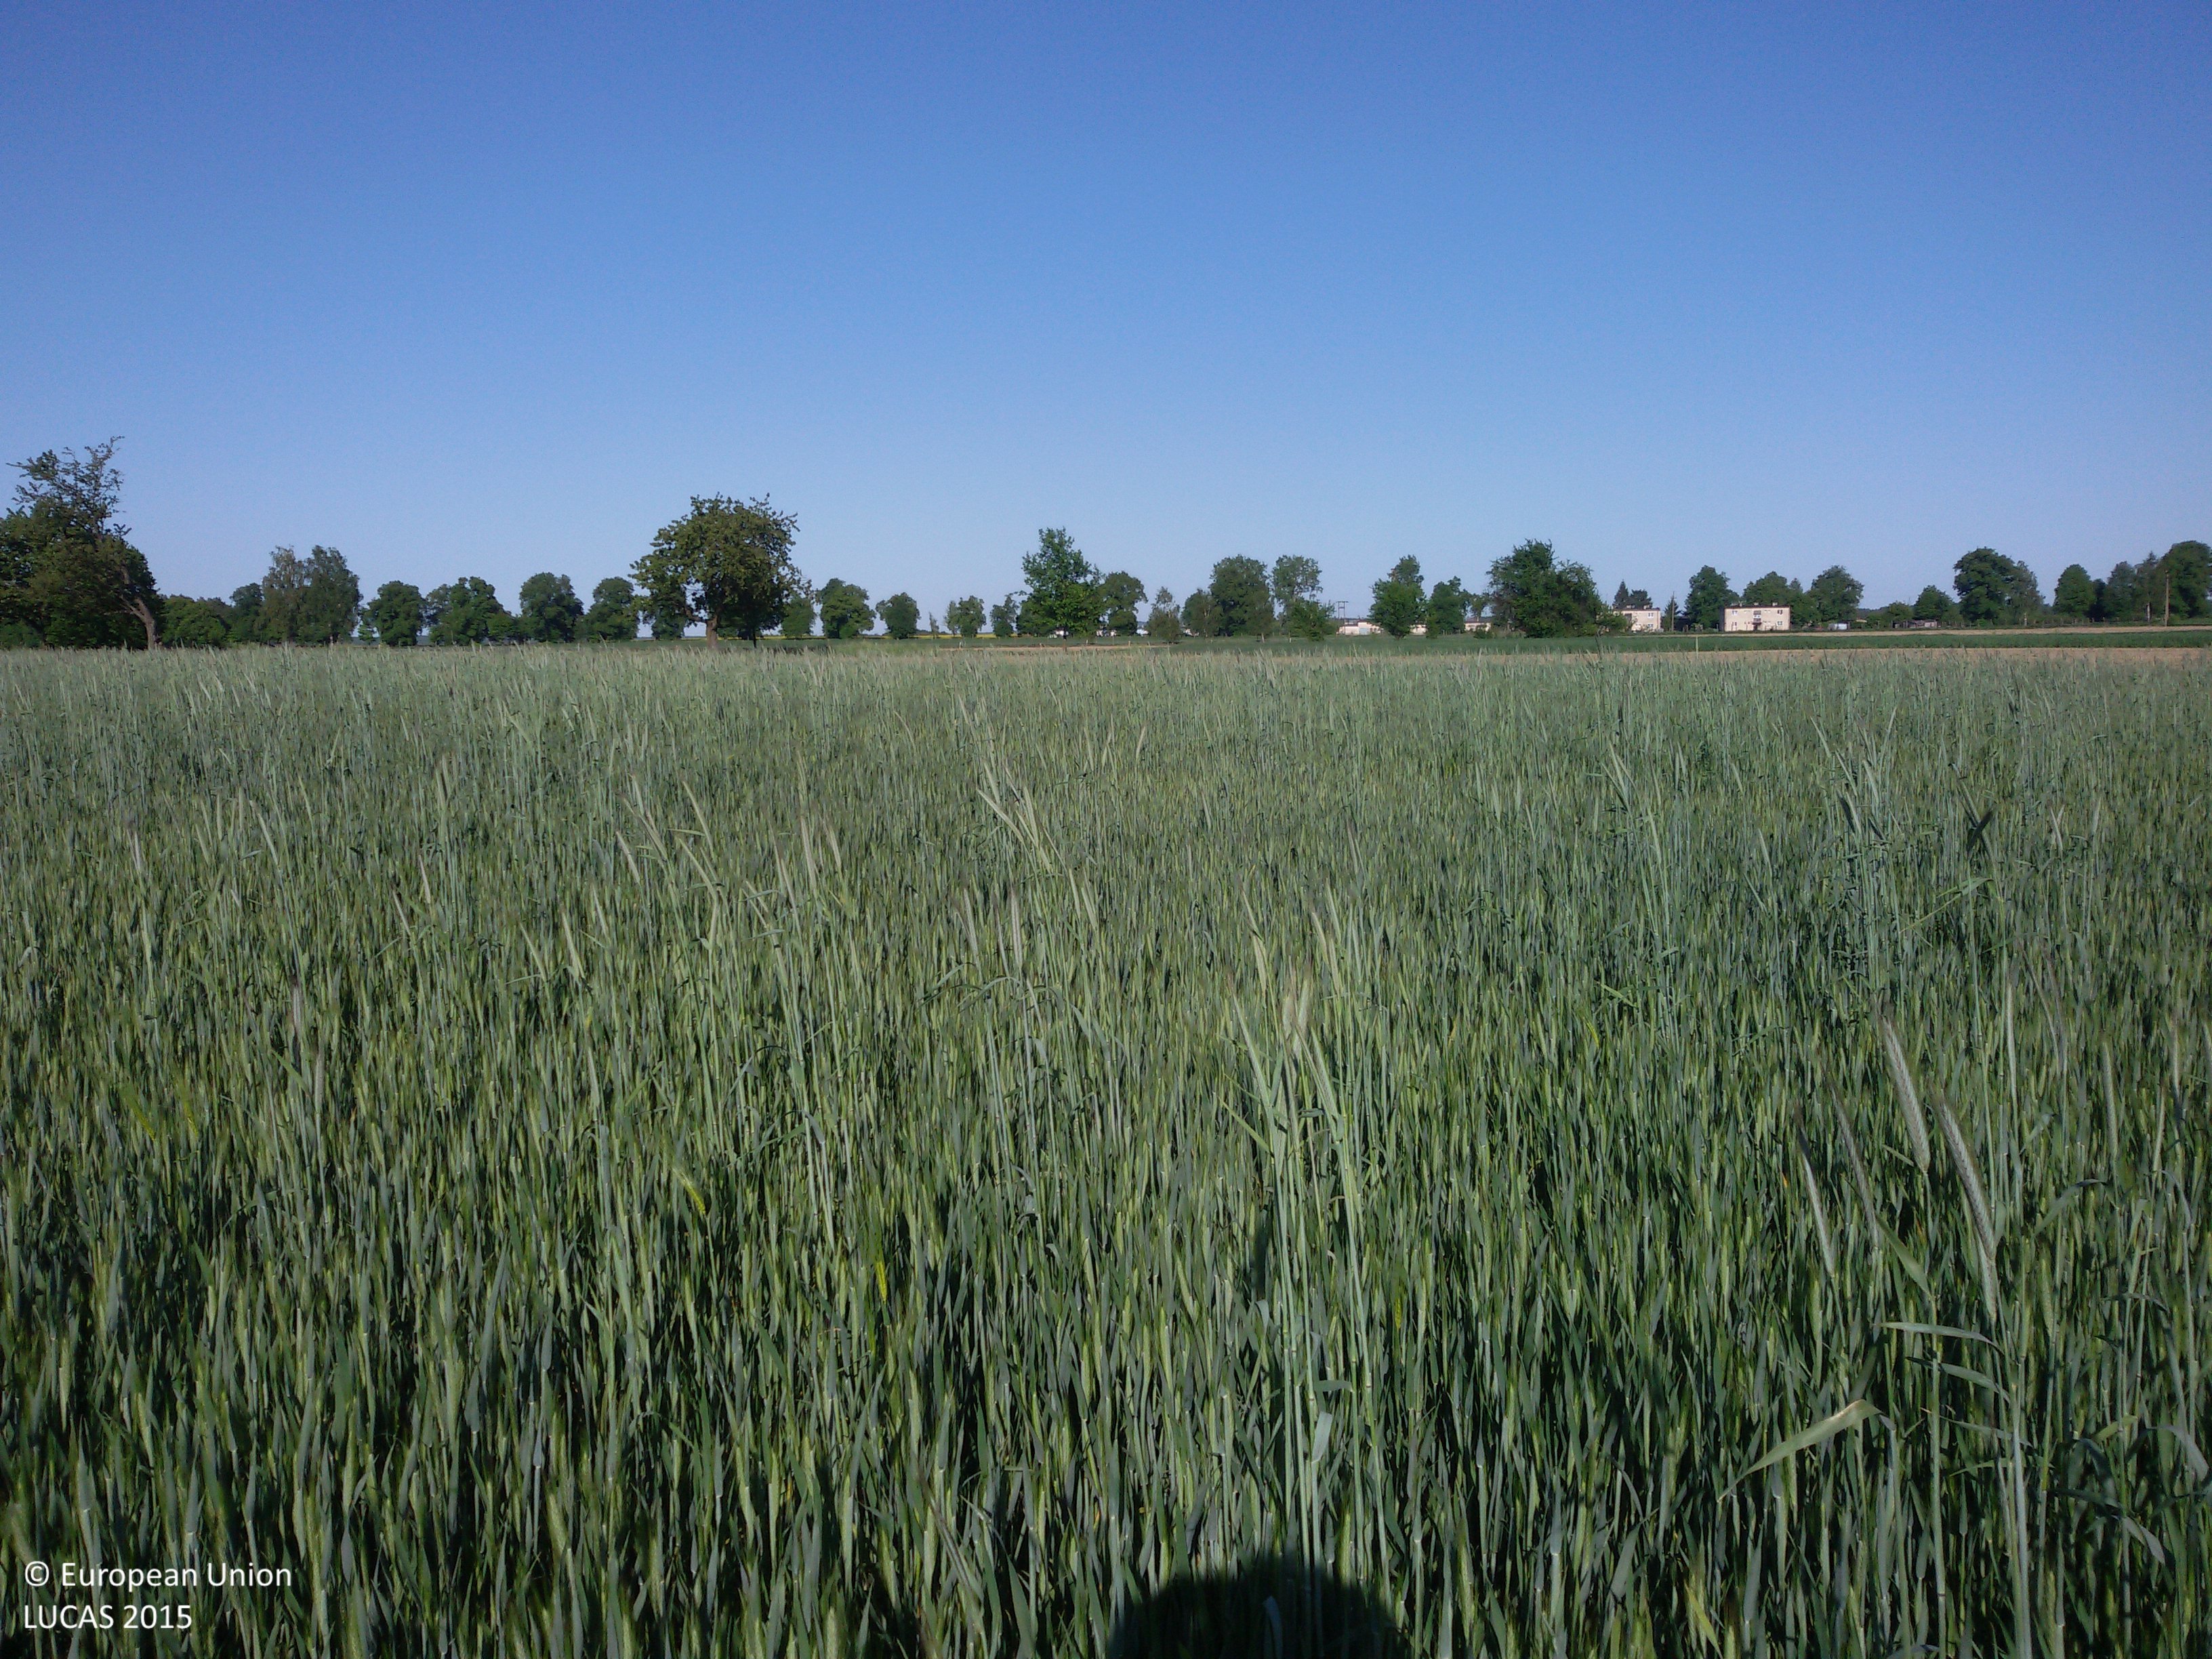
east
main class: Cropland
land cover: Triticale
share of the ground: > 75 %
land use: Agriculture (excluding fallow land and kitchen gardens)
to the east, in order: Triticale; Maize; Common wheat; Grass margins; Tracks; Lines of trees; Maize; Spontaneously vegetated surfaces; Inland marshes; Spontaneously vegetated surfaces
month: May
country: PL
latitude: 53.1244
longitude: 17.0480
